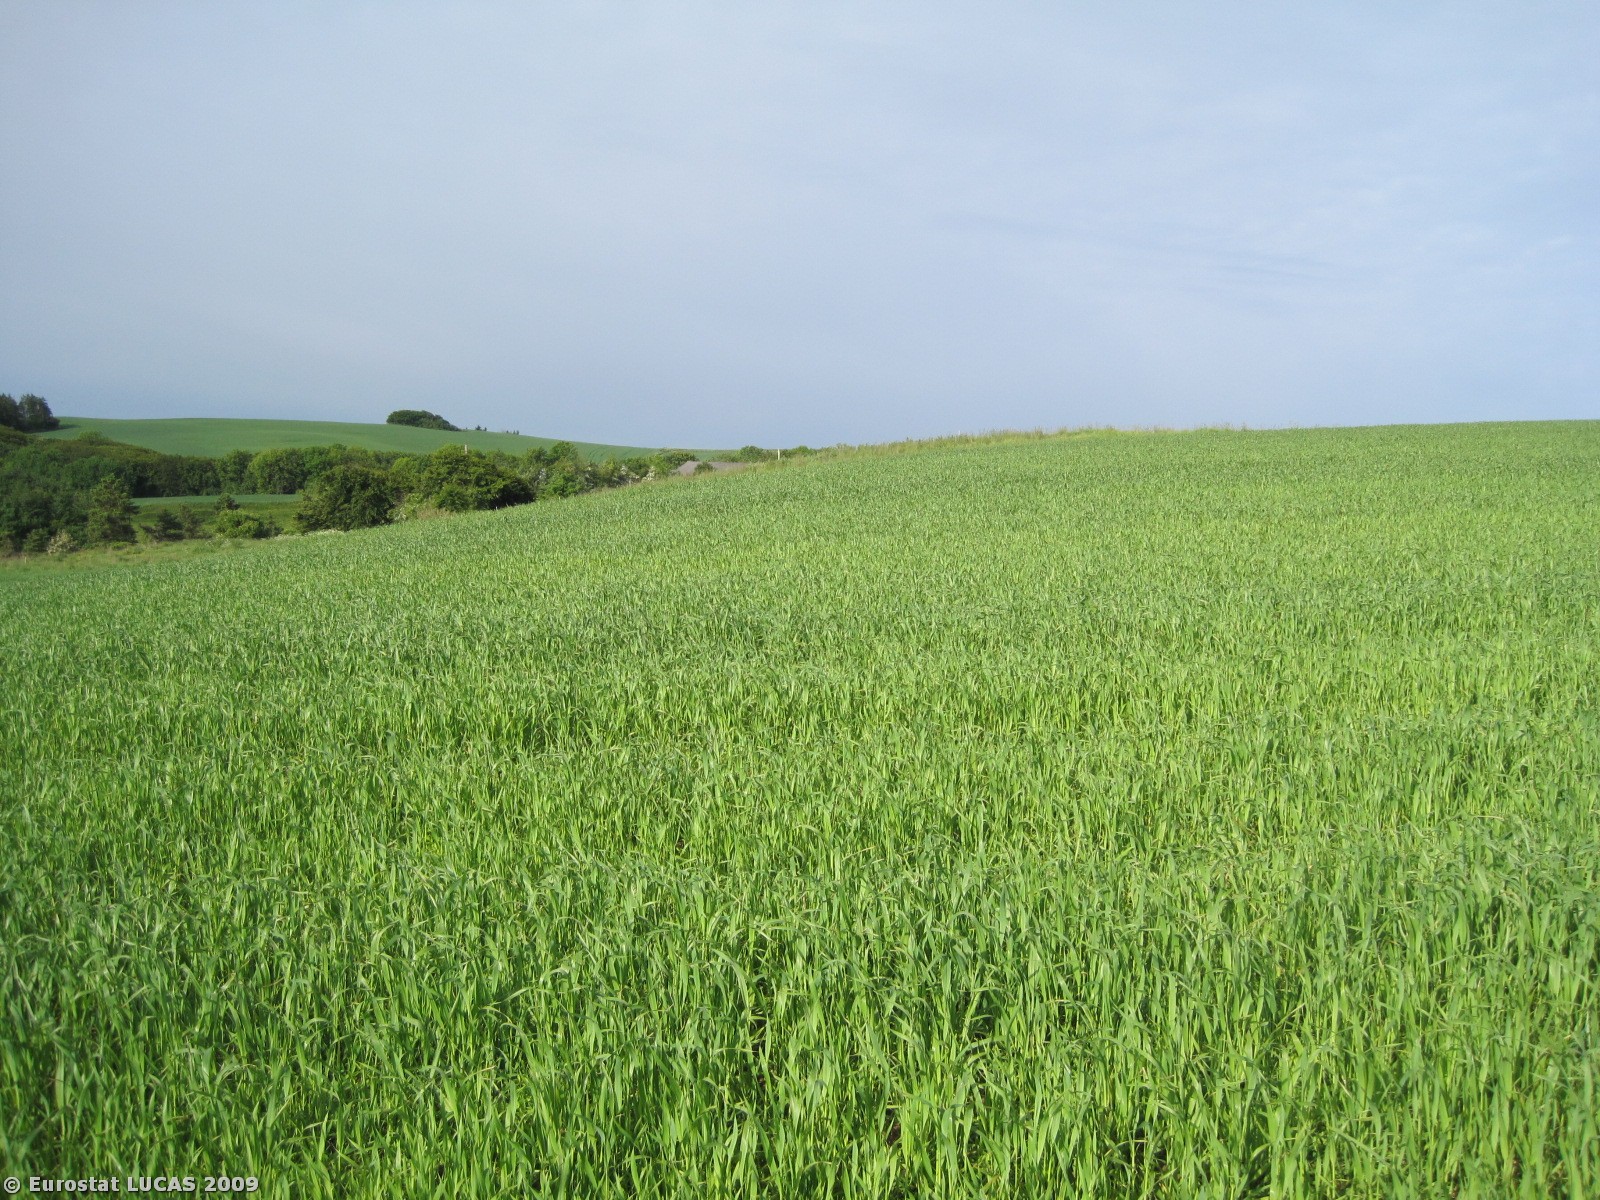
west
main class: Grassland
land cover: Grassland without tree/shrub cover
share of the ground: > 75 %
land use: Agriculture (excluding fallow land and kitchen gardens)
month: June
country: DK
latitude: 57.5361
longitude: 10.0500
